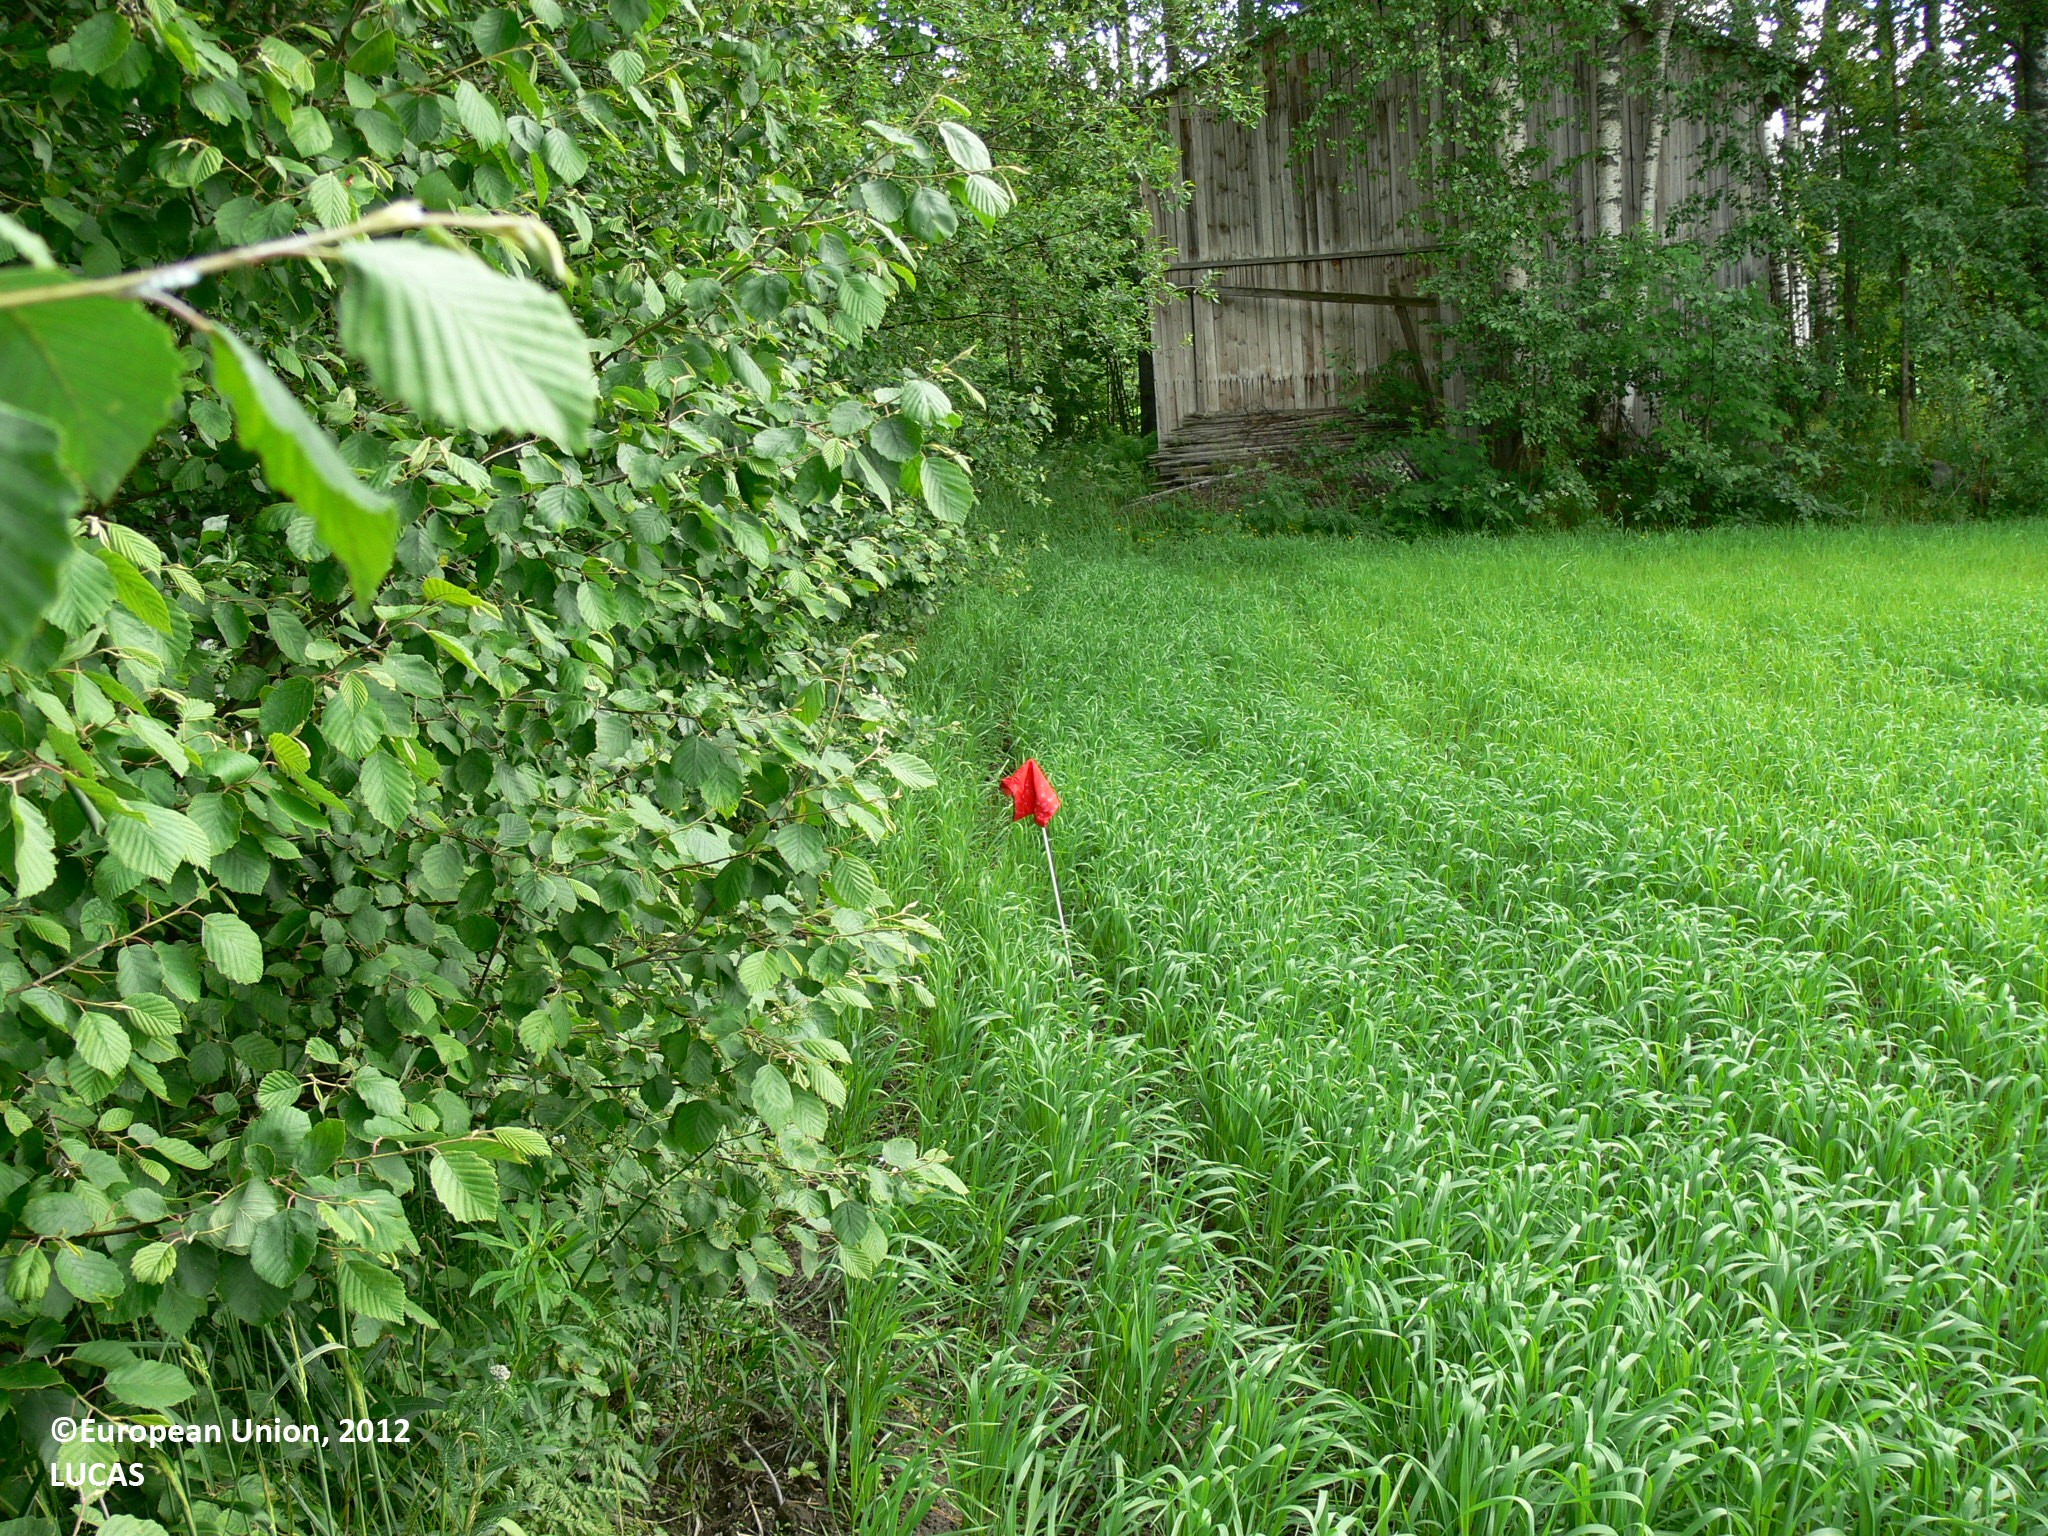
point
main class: Cropland
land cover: Oats
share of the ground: 50 - 75 %
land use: Agriculture (excluding fallow land and kitchen gardens)
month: June
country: FI
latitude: 62.4255
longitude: 29.5890
